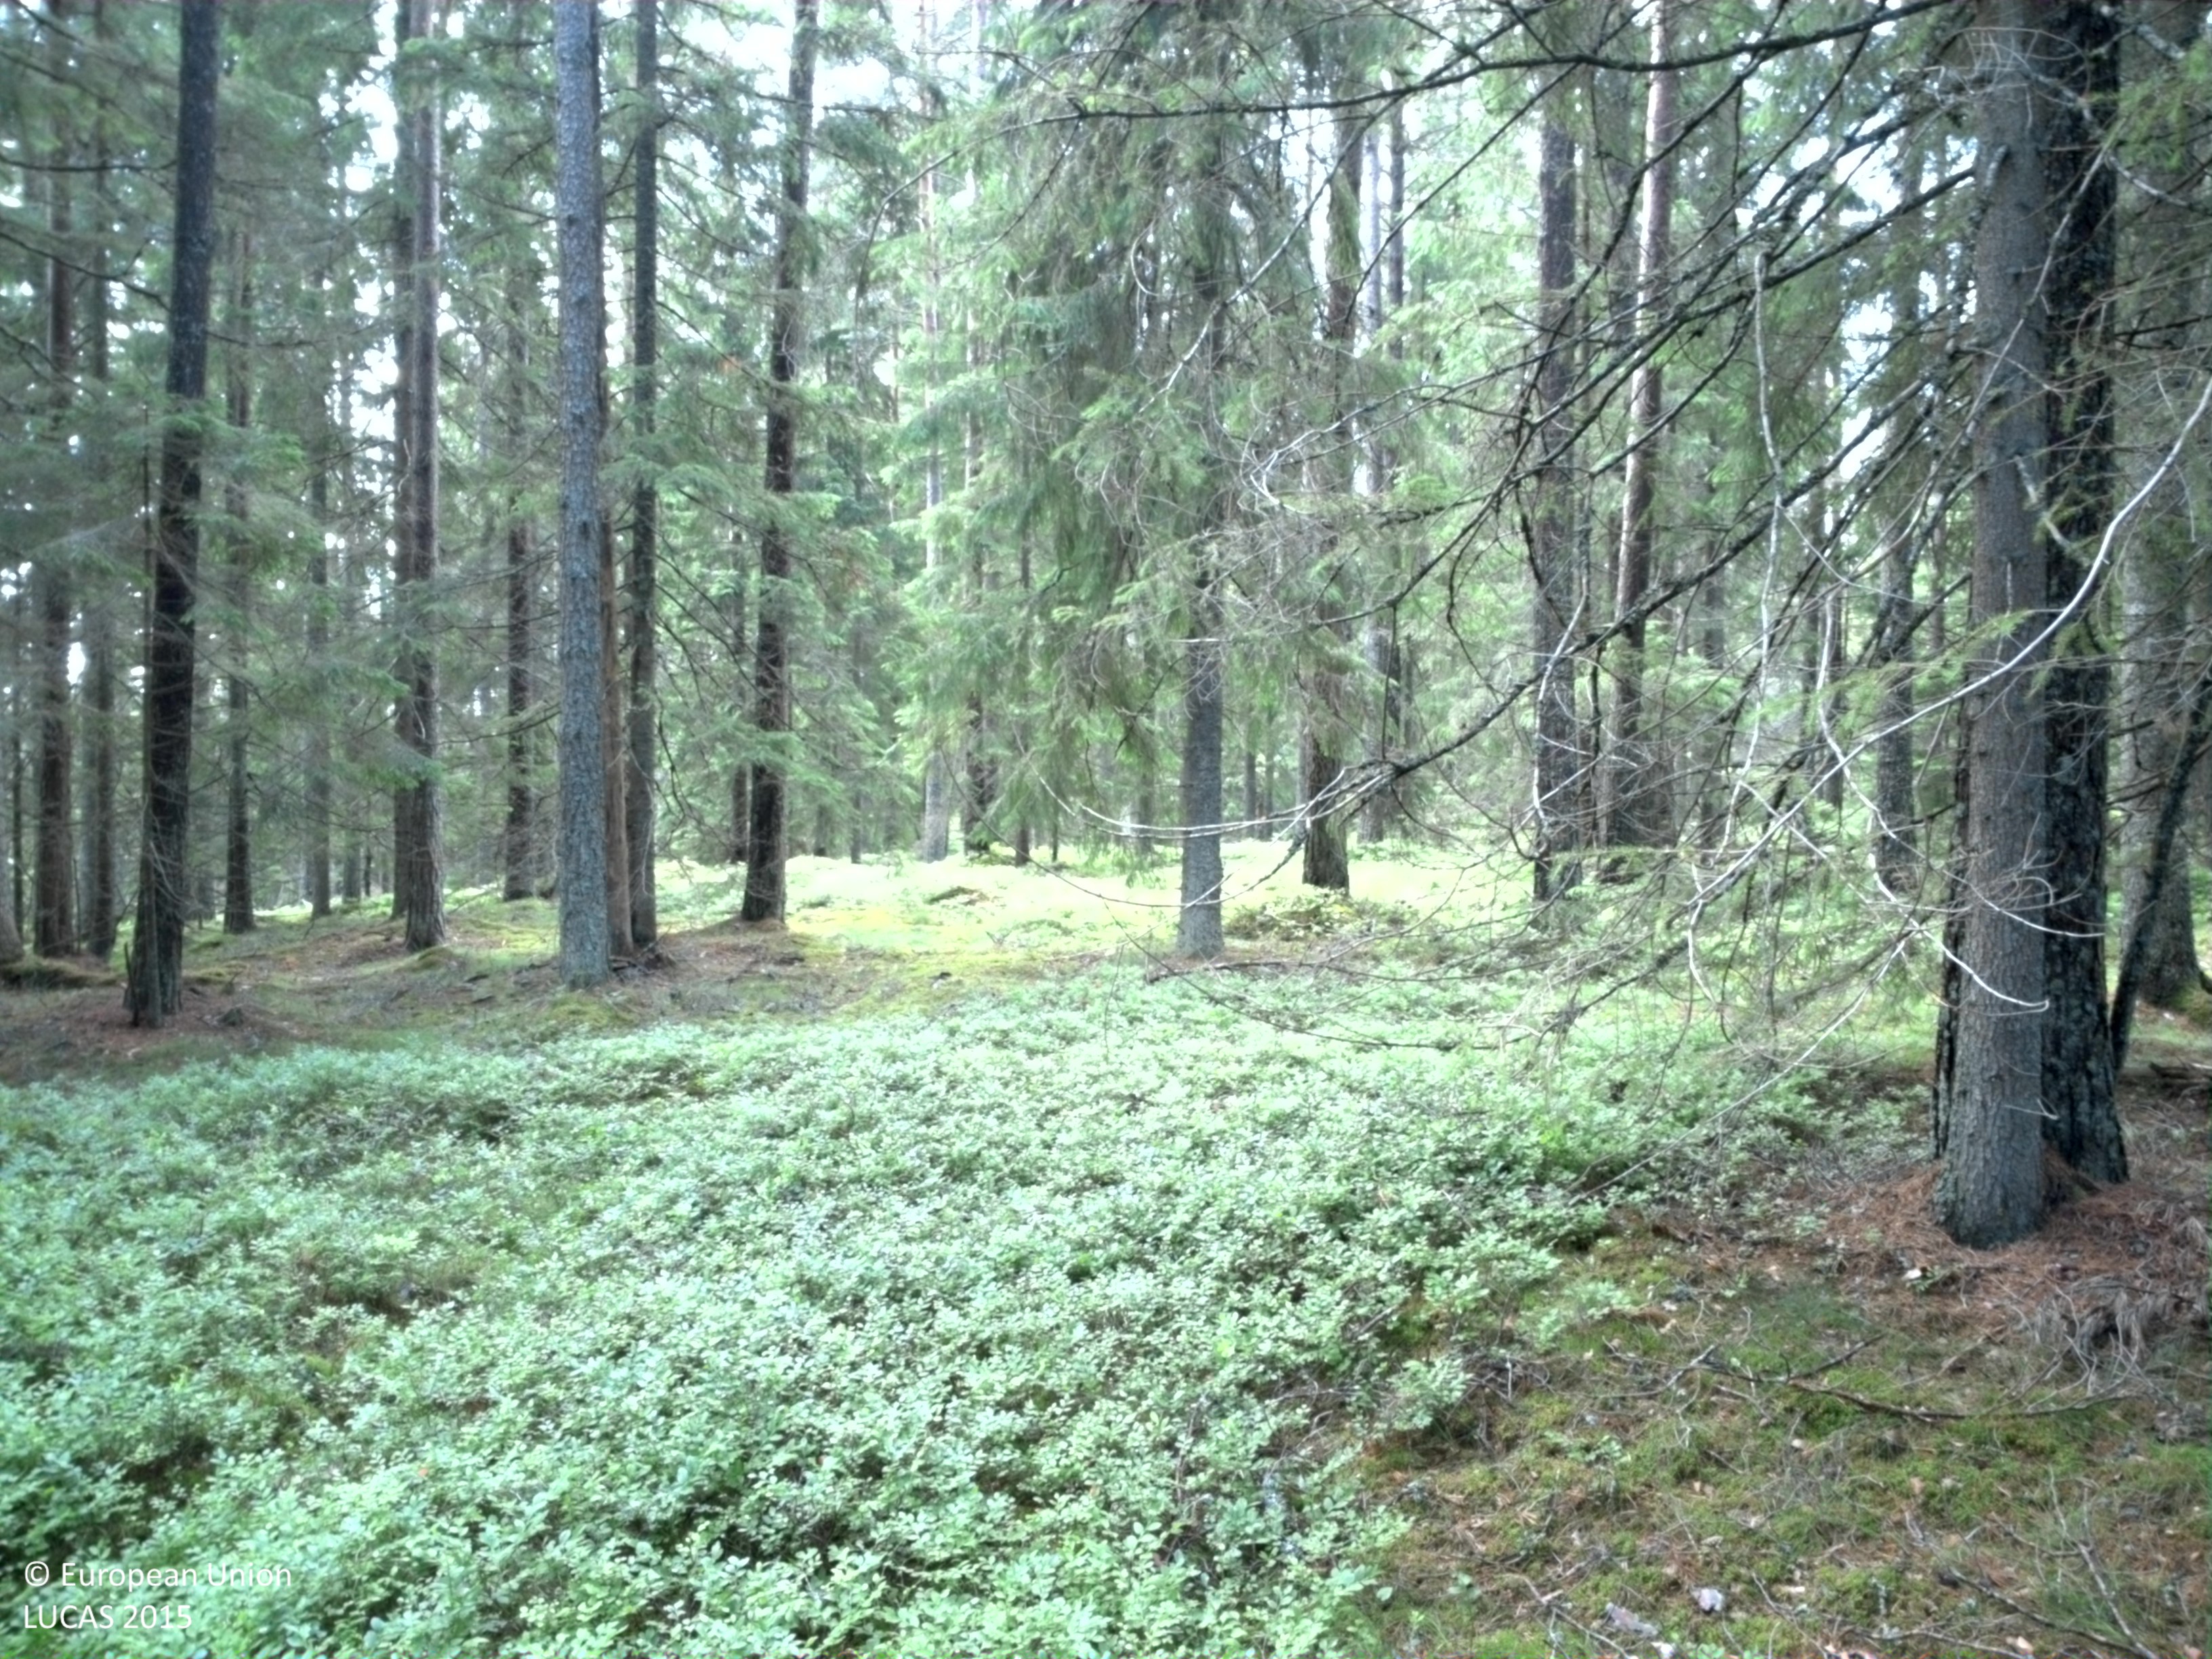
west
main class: Woodland
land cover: Other coniferous woodland
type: boreal forest
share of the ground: 50 - 75 %
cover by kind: coniferous forest trees 70 %, shrubs 15 %, lichens and mosses 15 %
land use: Forestry
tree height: > 5 m
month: July
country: SE
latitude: 58.4202
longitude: 14.3251
